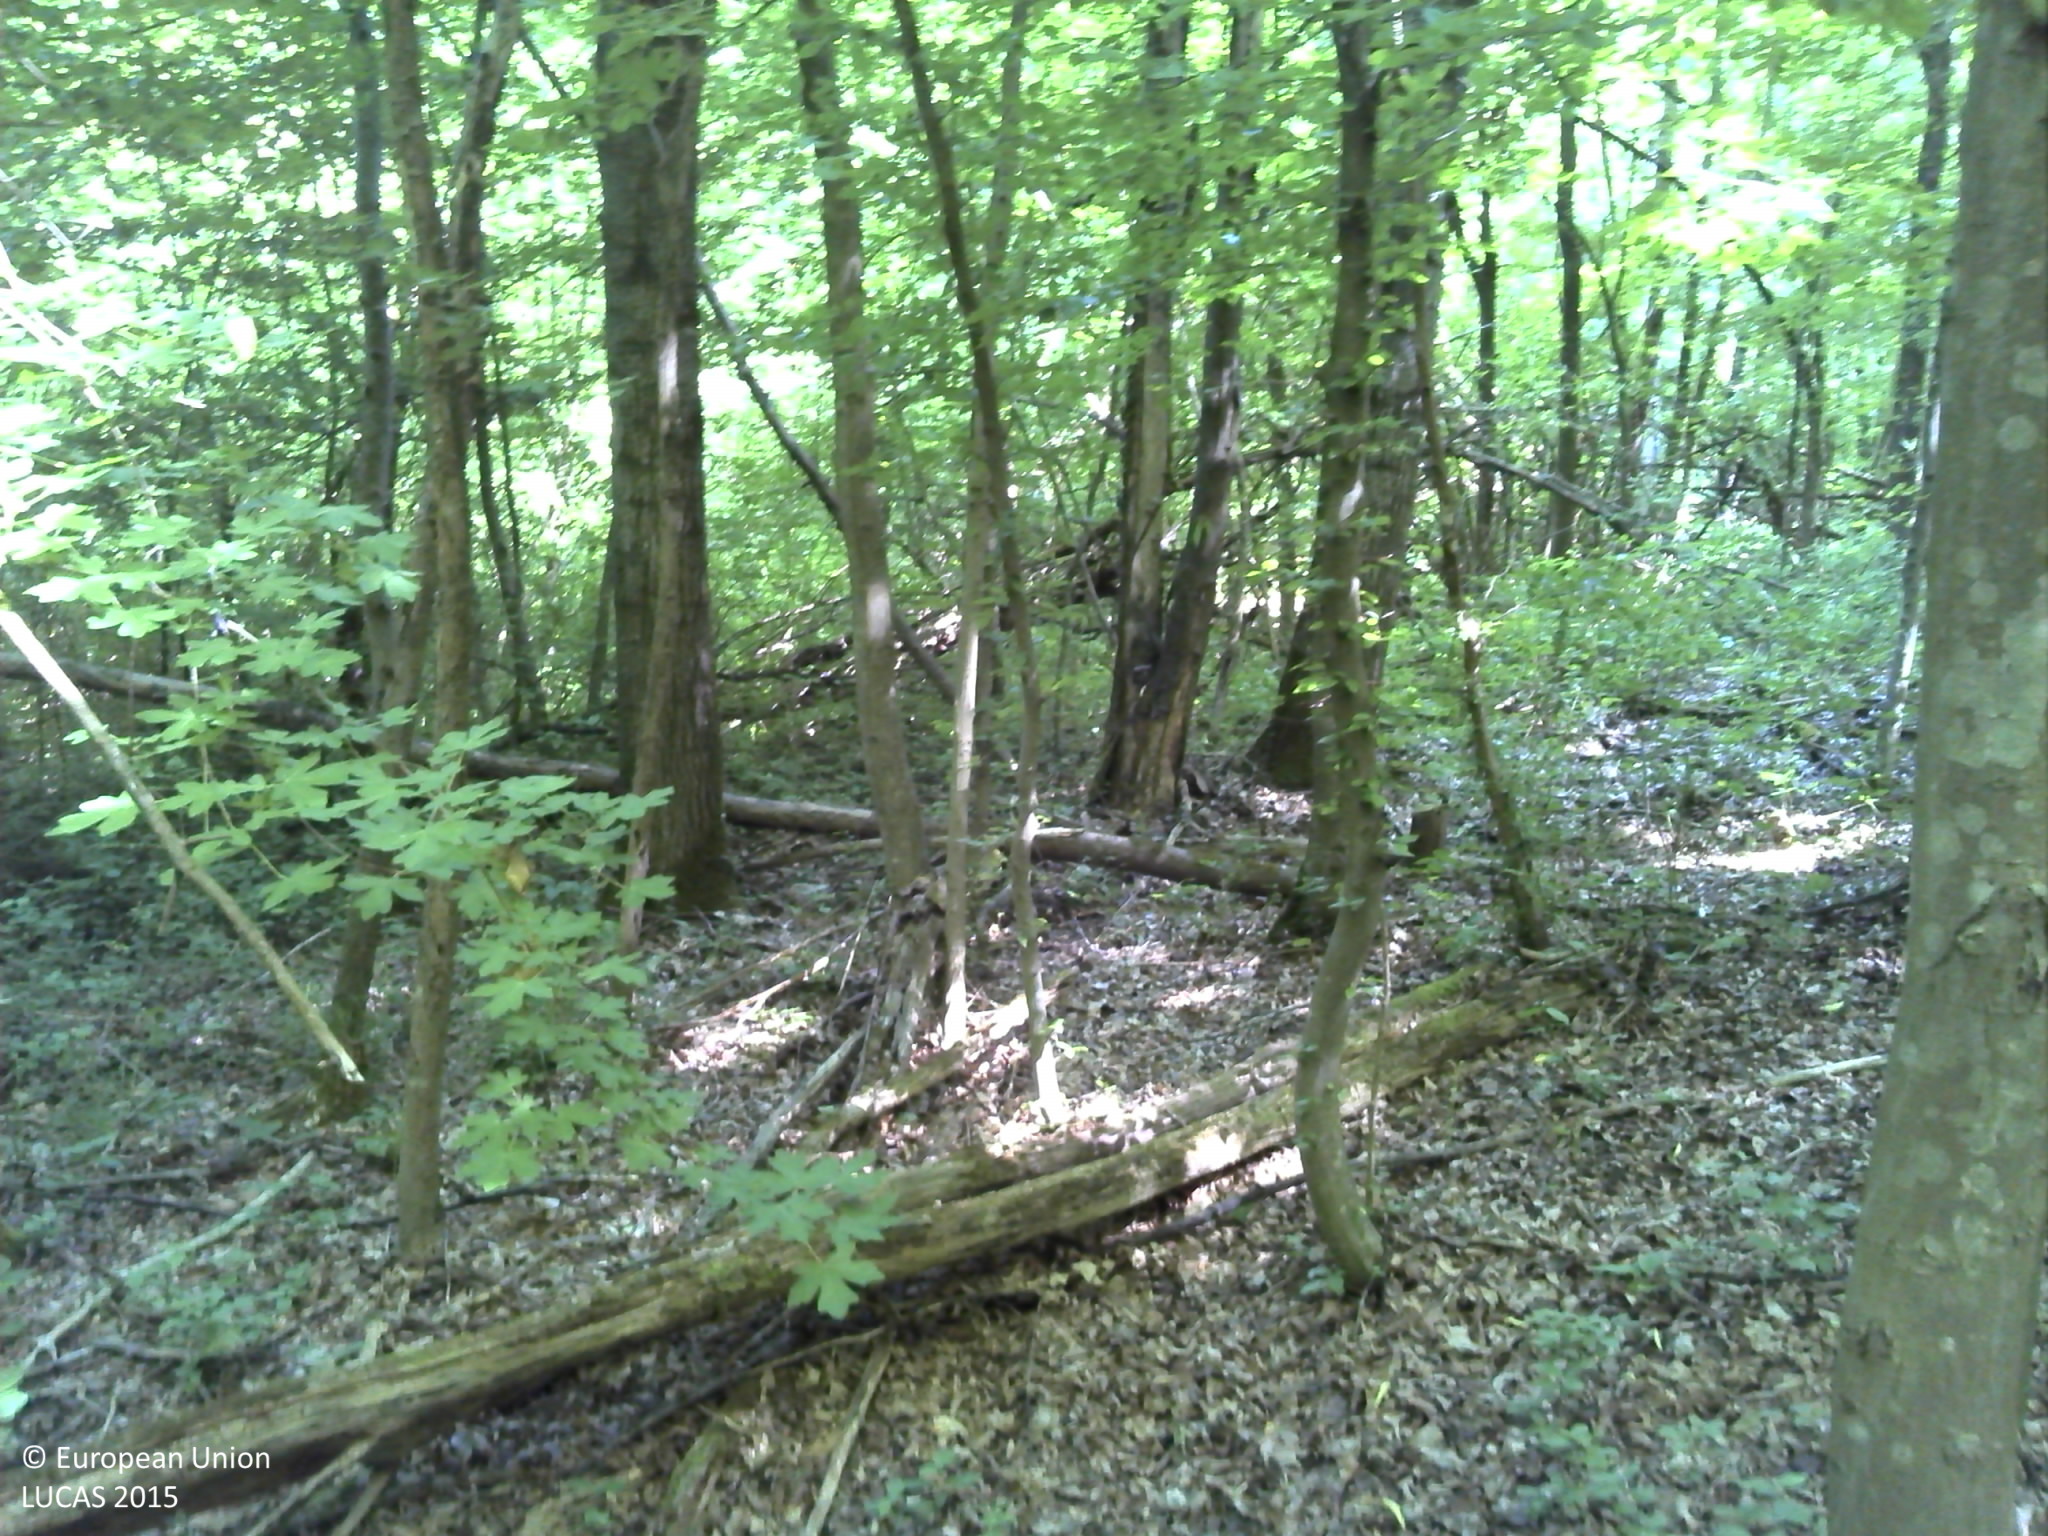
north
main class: Woodland
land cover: Broadleaved woodland
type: beech forest
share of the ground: > 75 %
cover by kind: broadleaved forest trees 100 %
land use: Forestry
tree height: > 5 m
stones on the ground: < 10 %
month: May
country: HR
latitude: 45.4504
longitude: 18.0464
